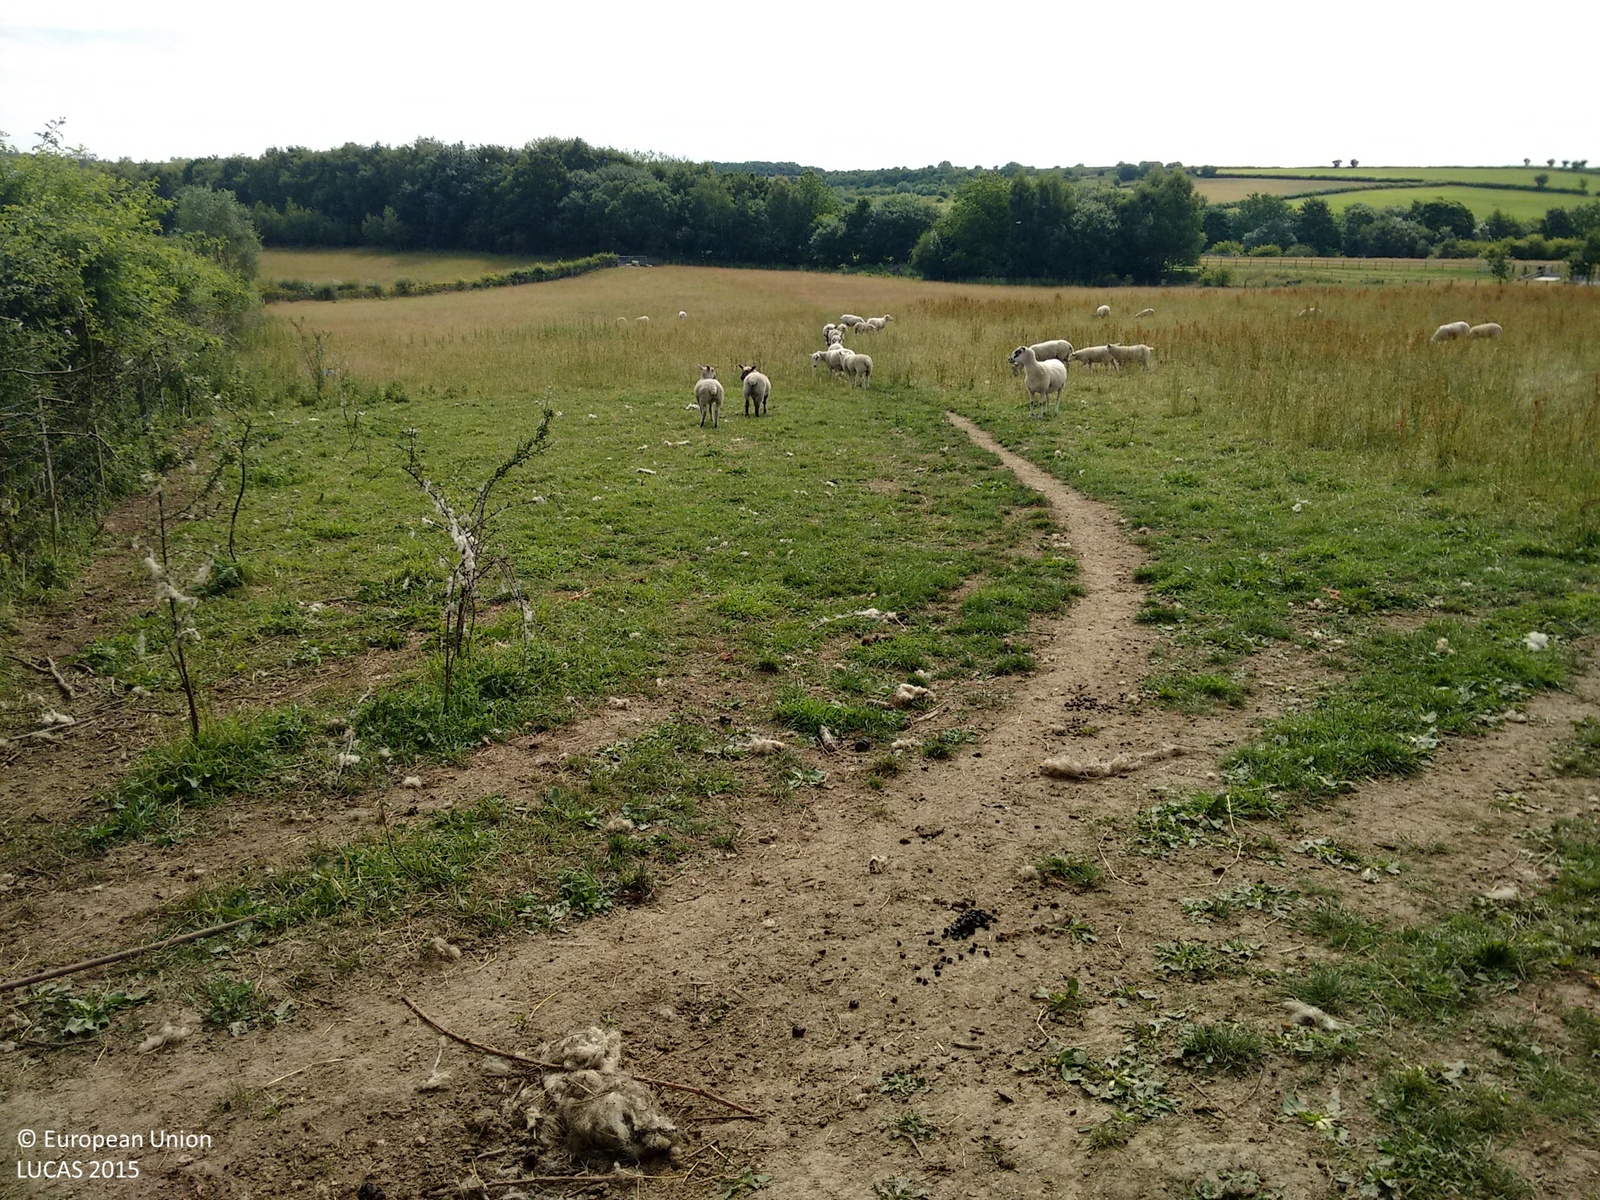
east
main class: Grassland
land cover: Grassland without tree/shrub cover
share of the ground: > 75 %
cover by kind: herbaceous plants 100 %
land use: Agriculture (excluding fallow land and kitchen gardens)
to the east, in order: Grassland without tree/shrub cover; Fences; Managed hedges; Grassland without tree/shrub cover; Broadleaved woodland; Fences; Grassland without tree/shrub cover; Fences; Abandoned hedges
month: July
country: GB
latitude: 53.0227
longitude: -1.4246
